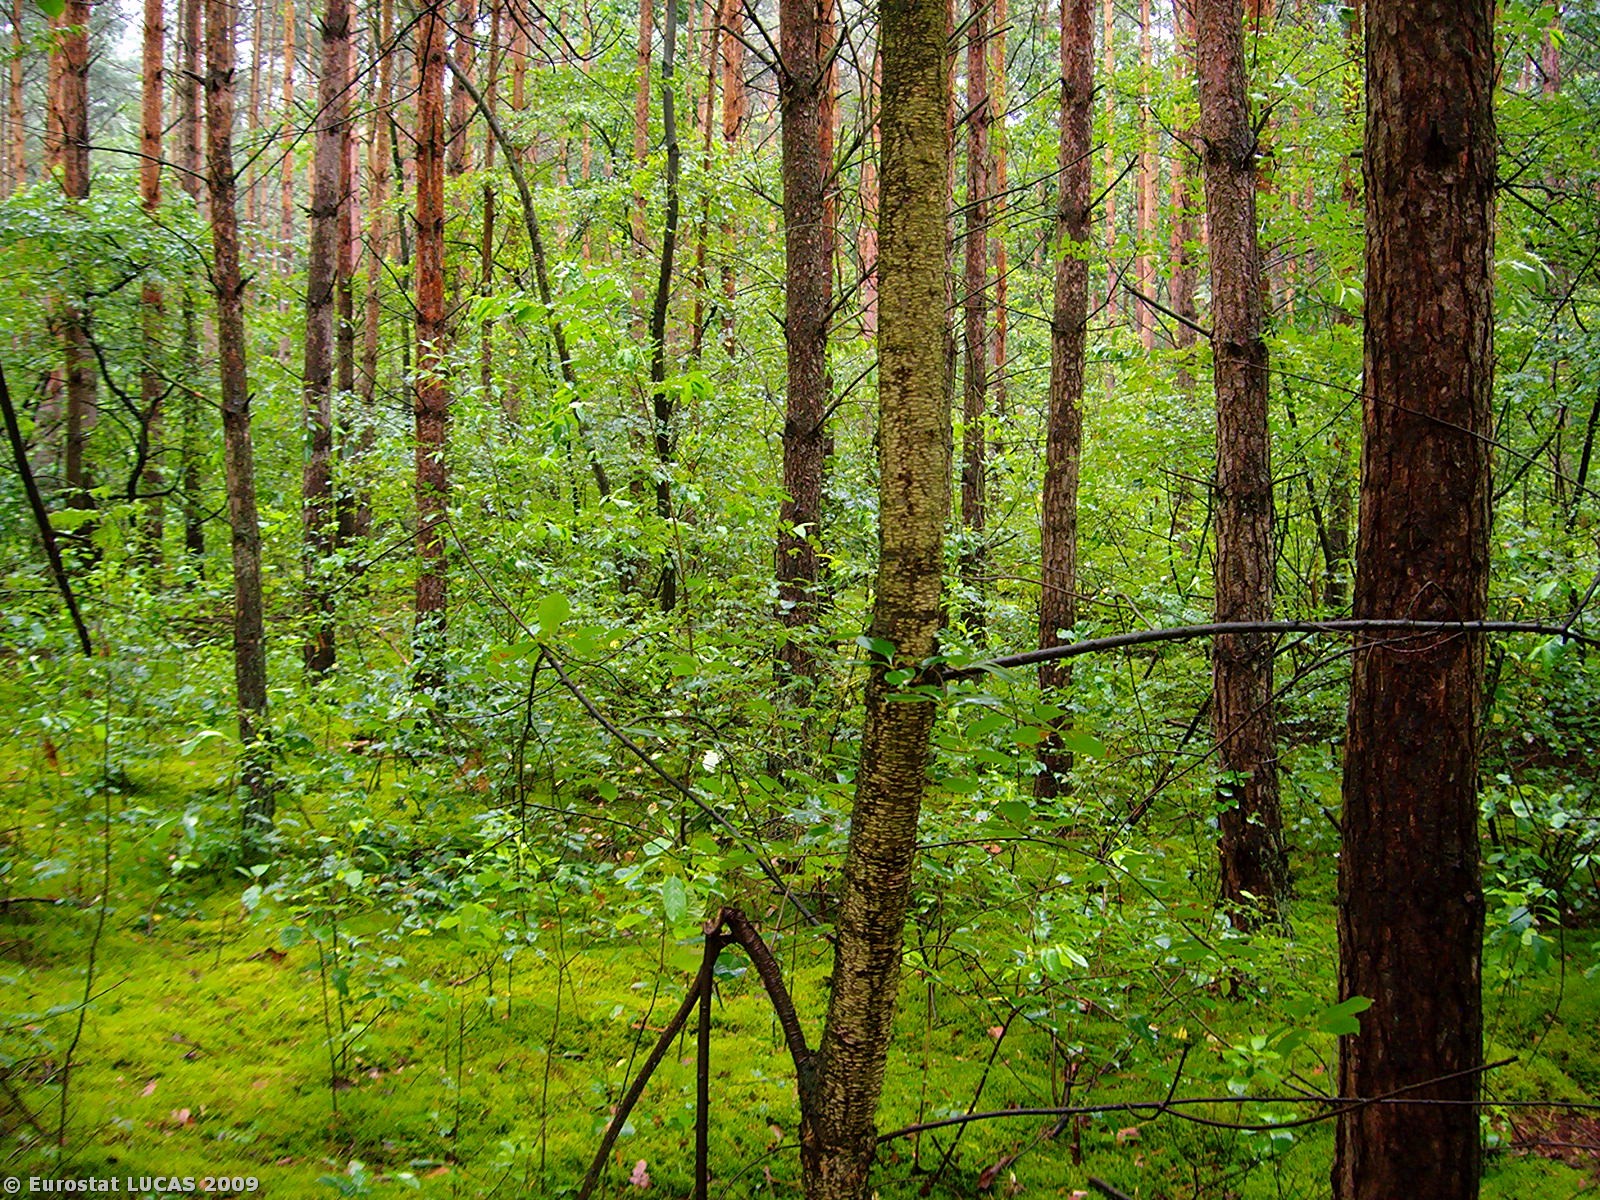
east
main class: Woodland
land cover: Mixed woodland
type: hemiboreal forest and nemoral coniferous forest and mixed broadleaved-coniferous forest
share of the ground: > 75 %
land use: Forestry
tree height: > 5 m
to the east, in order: Mixed woodland; Tracks; Mixed woodland
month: July
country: PL
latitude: 52.6768
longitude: 15.2241
